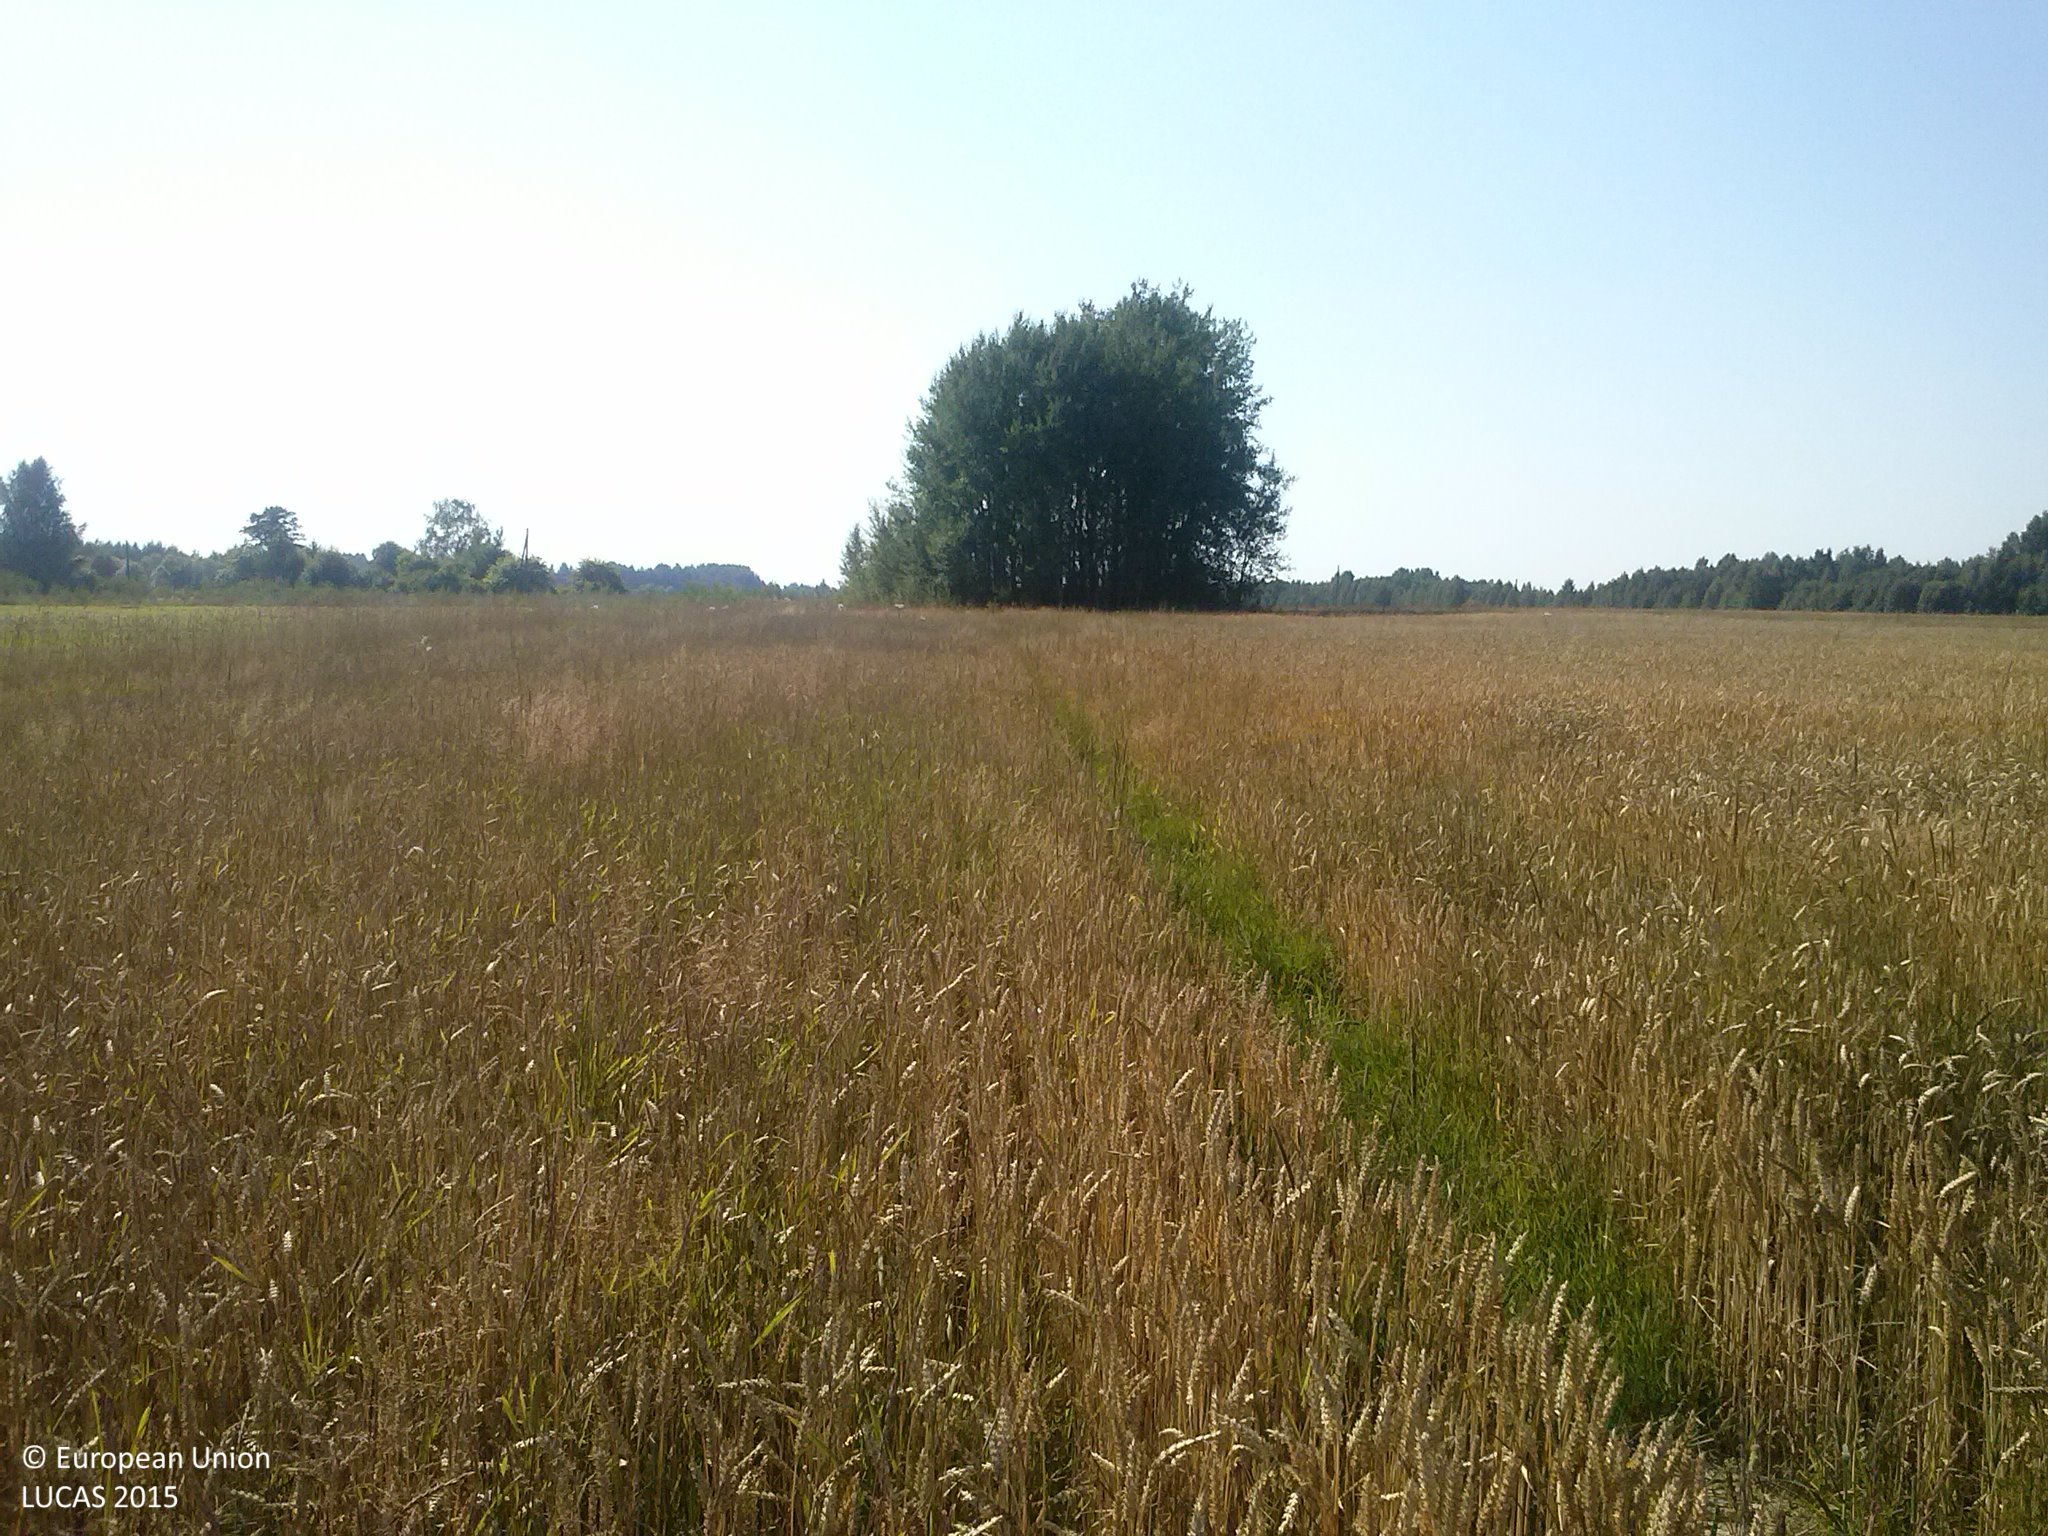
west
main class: Cropland
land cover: Common wheat
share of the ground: > 75 %
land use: Agriculture (excluding fallow land and kitchen gardens)
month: August
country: LV
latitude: 56.6998
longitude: 27.8103
